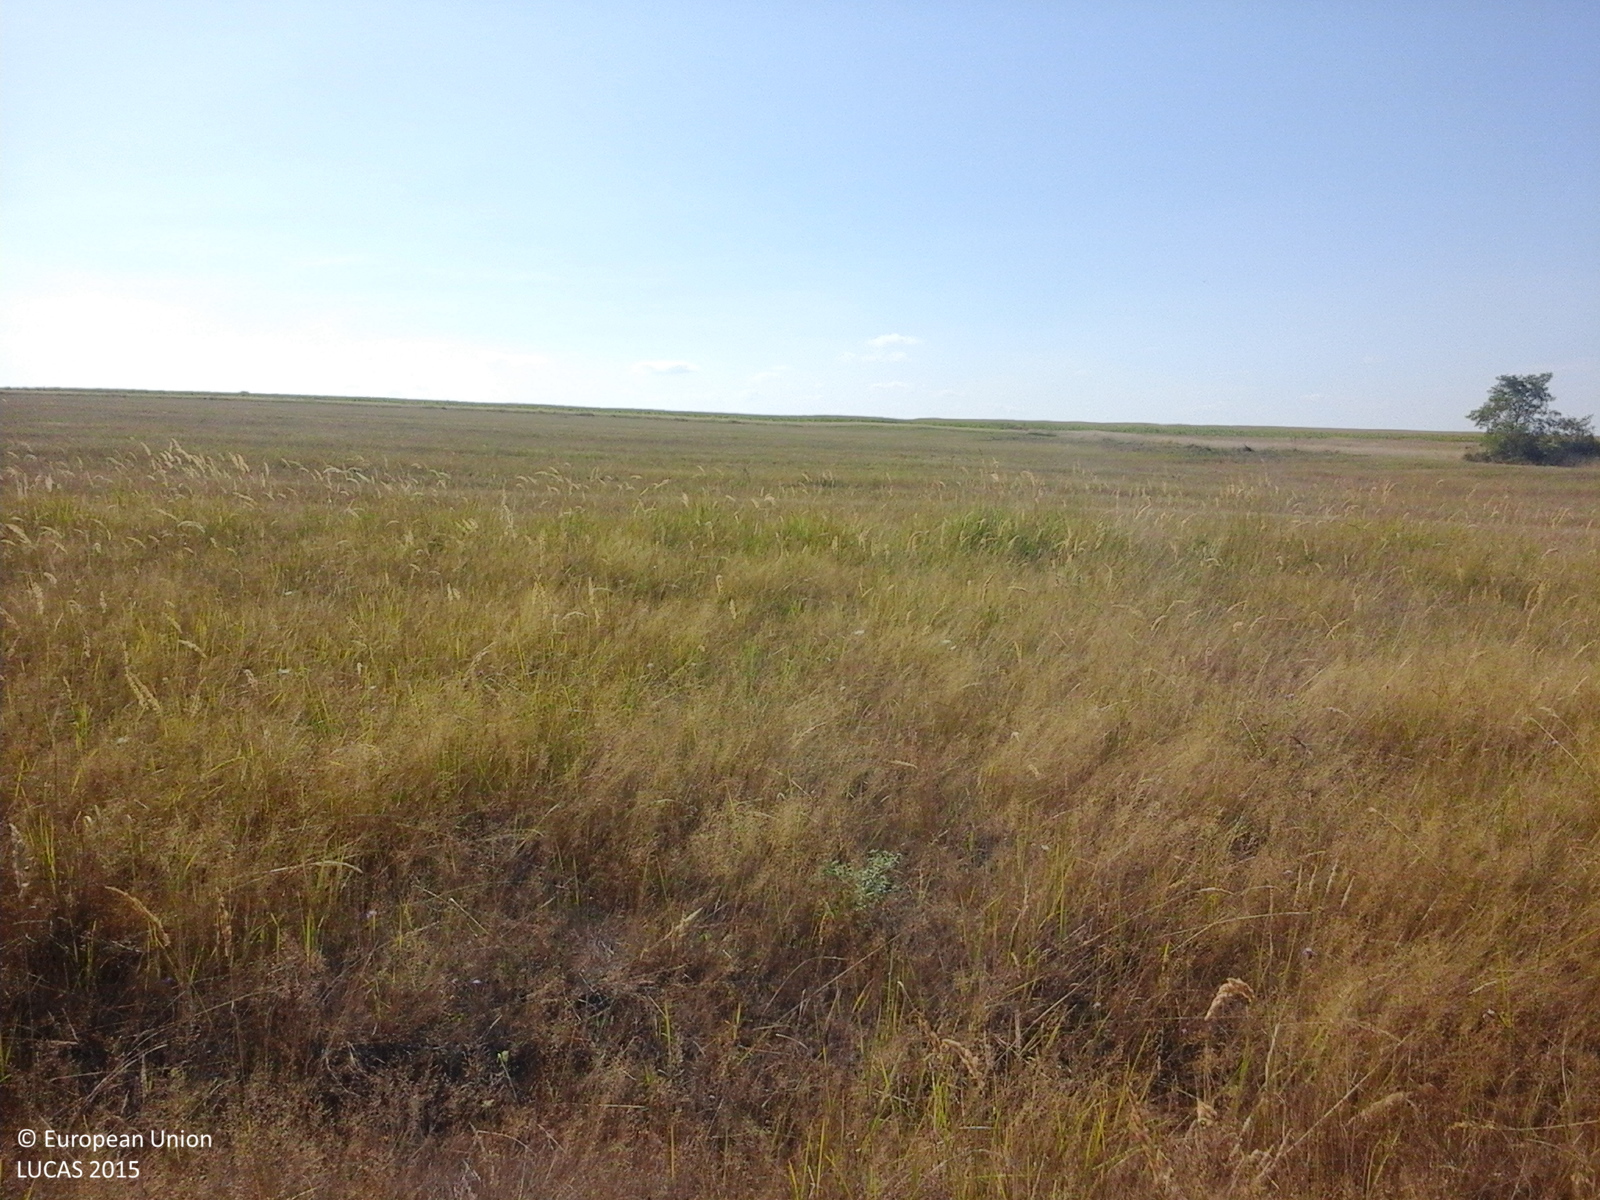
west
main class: Grassland
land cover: Grassland without tree/shrub cover
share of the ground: > 75 %
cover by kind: herbaceous plants 100 %
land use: Agriculture (excluding fallow land and kitchen gardens)
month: August
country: RO
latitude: 45.3912
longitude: 21.5923
